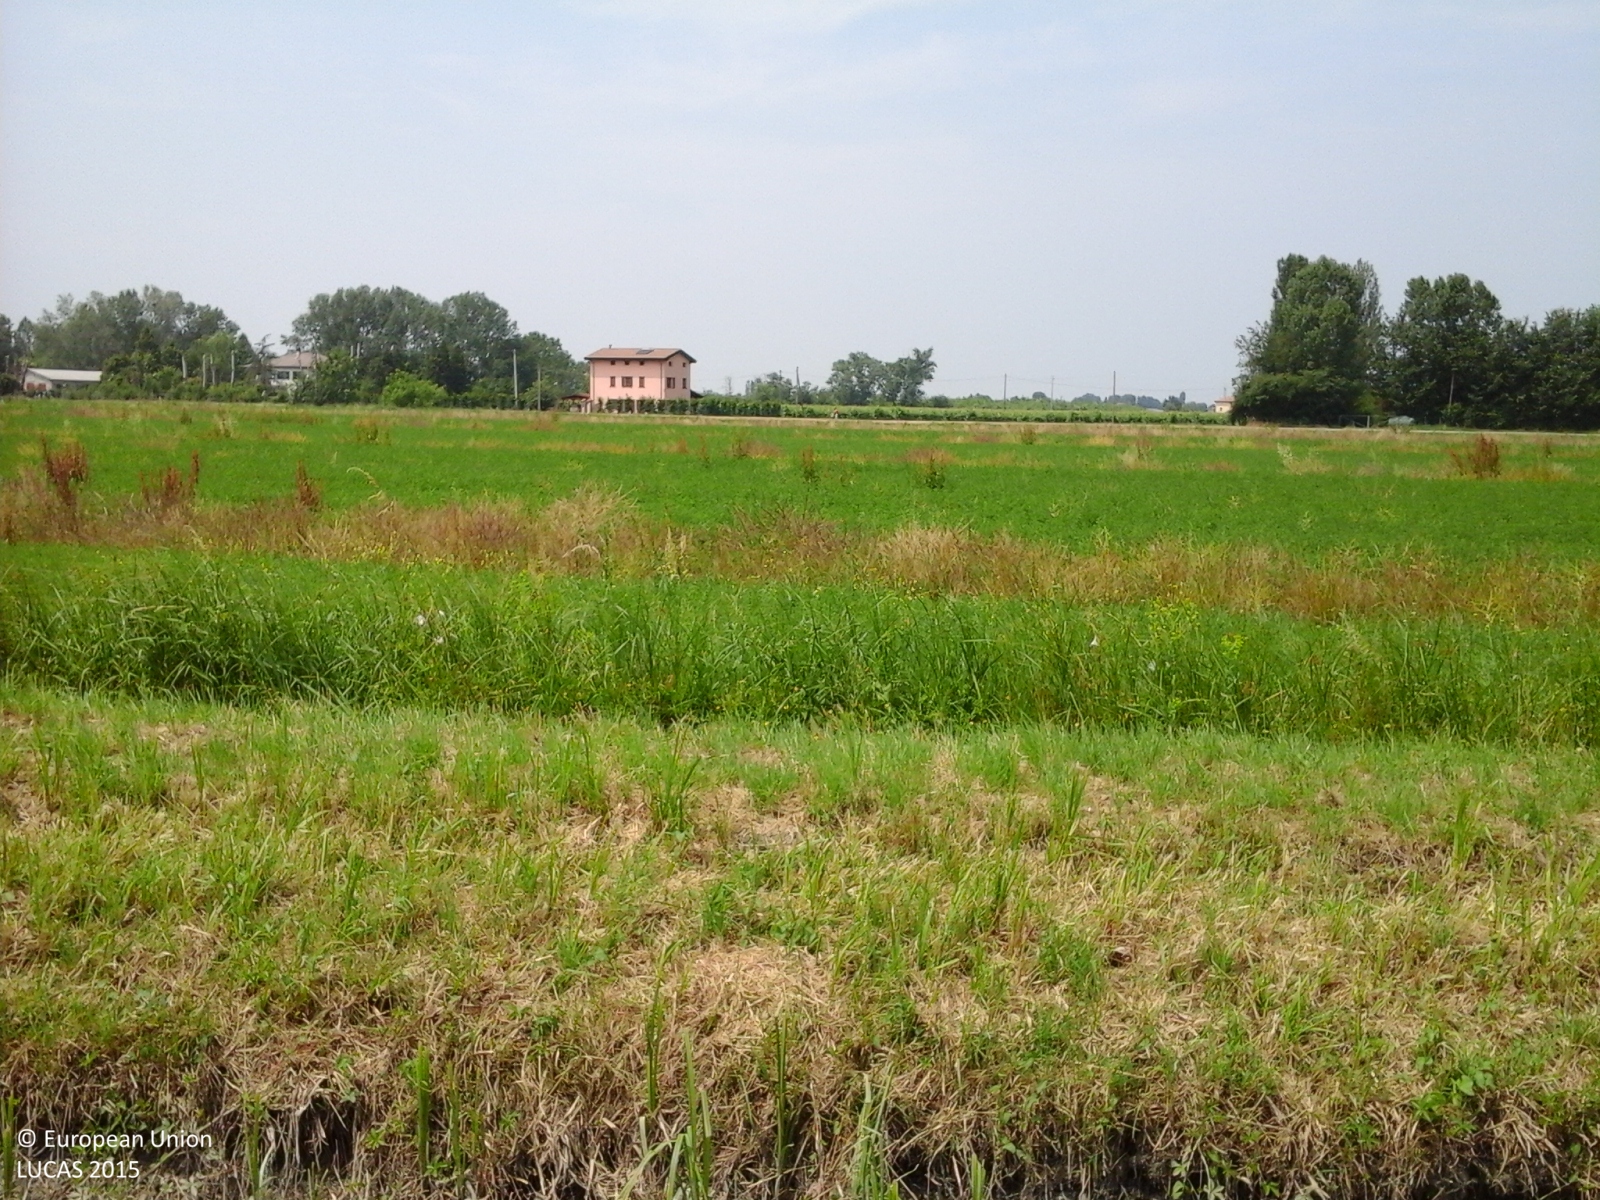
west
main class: Grassland
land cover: Grassland without tree/shrub cover
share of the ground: > 75 %
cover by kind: herbaceous plants 100 %
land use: Agriculture (excluding fallow land and kitchen gardens)
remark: Clear cut
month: May
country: IT
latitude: 44.7441
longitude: 10.8192
